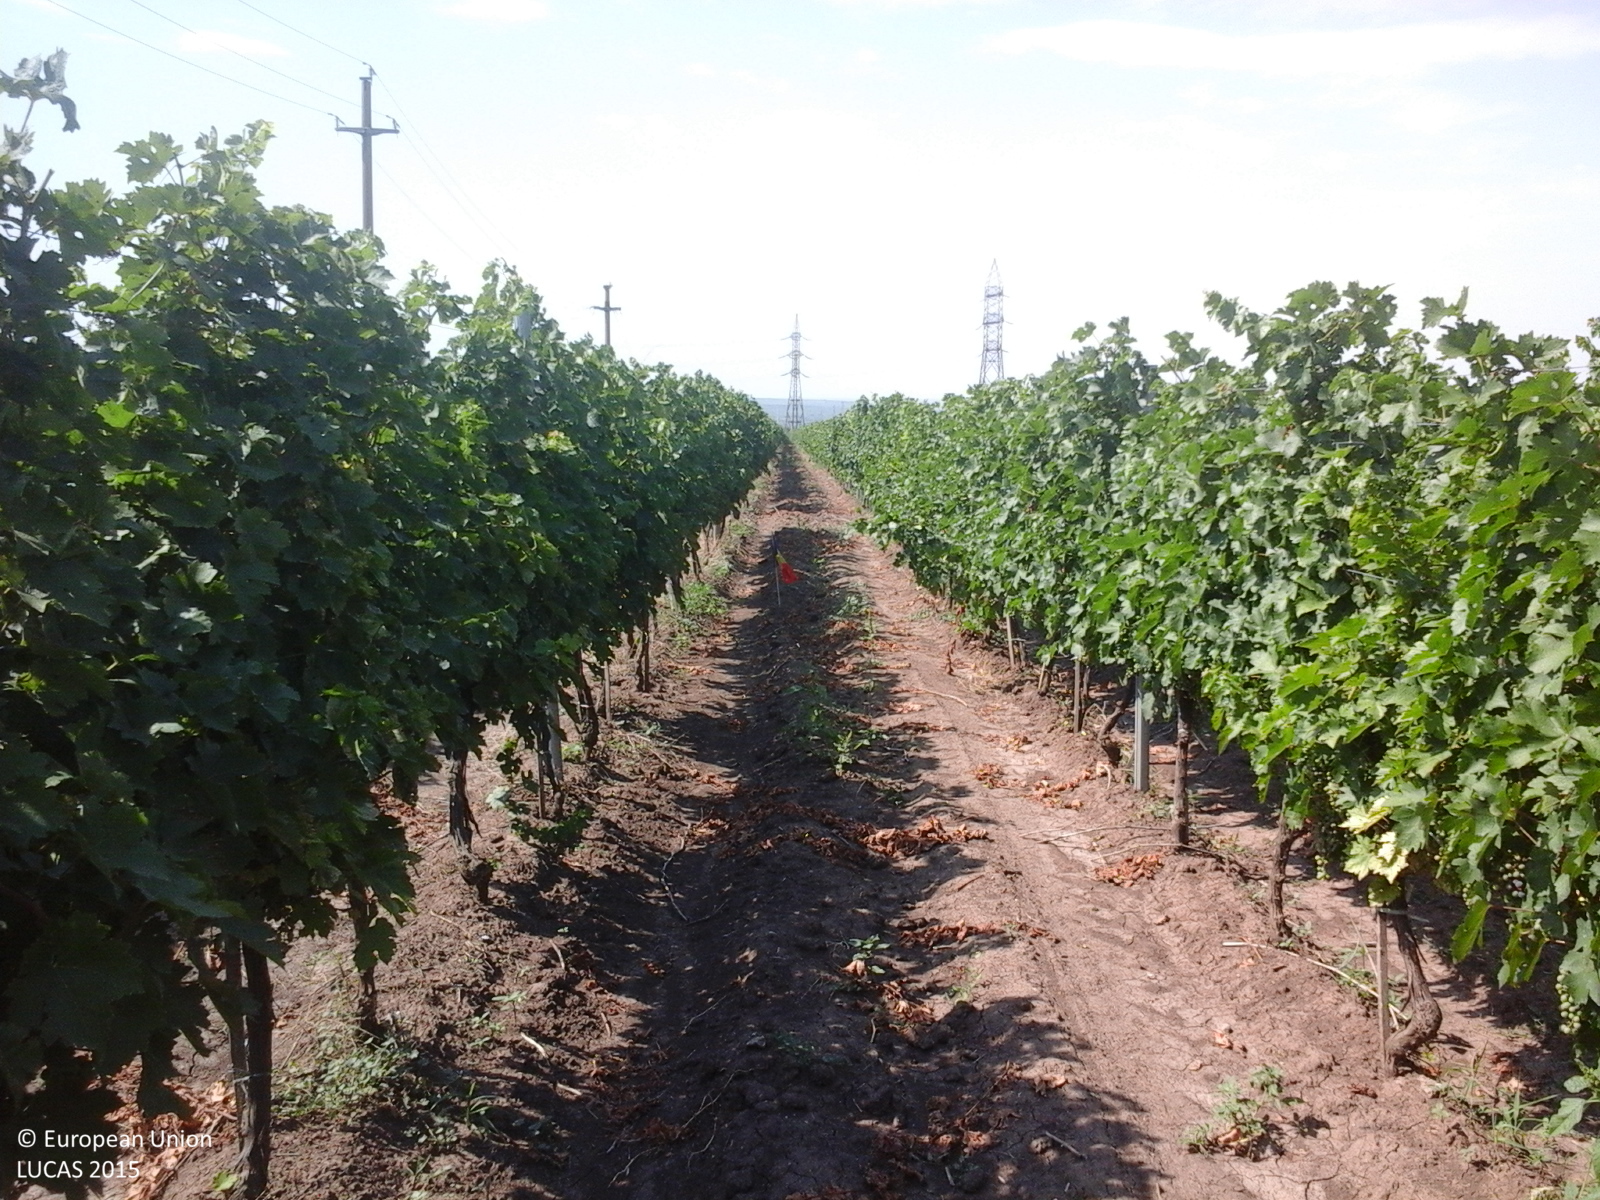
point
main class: Cropland
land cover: Vineyards
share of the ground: > 75 %
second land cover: Other bare soil
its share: > 75 %
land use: Agriculture (excluding fallow land and kitchen gardens)
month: August
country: RO
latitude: 44.1626
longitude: 28.4116
